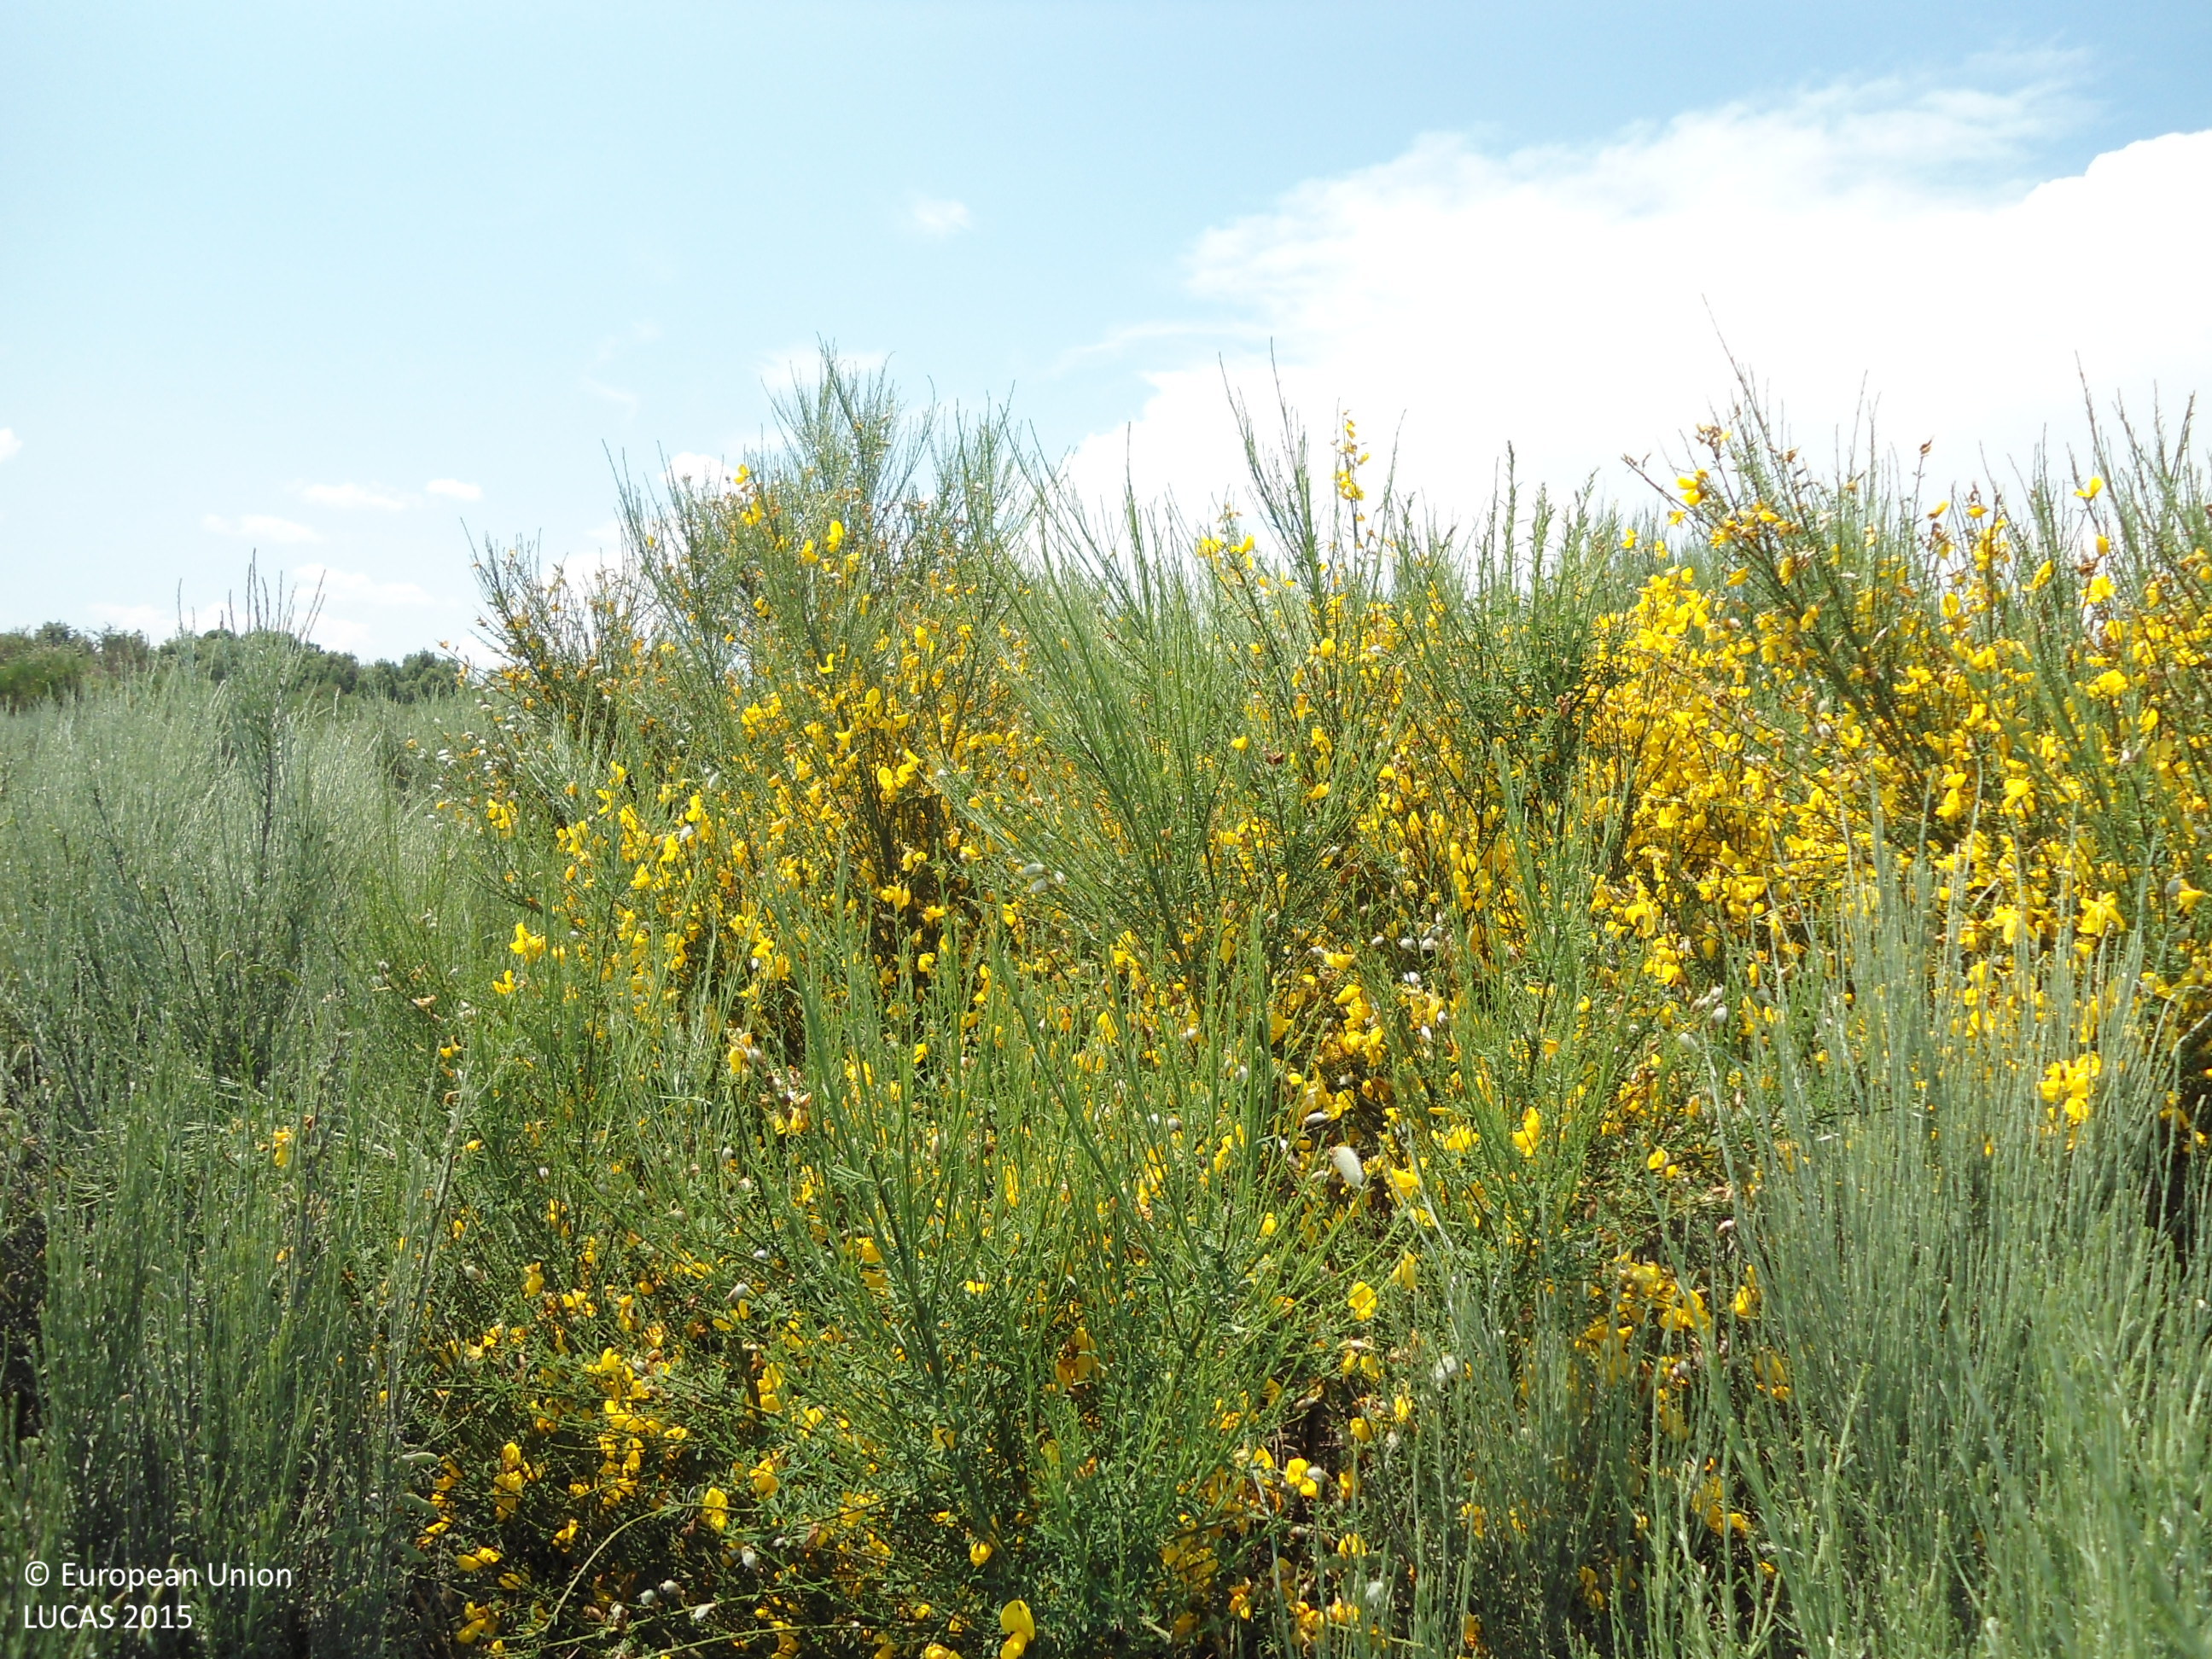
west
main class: Shrubland
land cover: Shrubland without tree cover
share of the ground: > 75 %
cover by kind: shrubs 95 %, herbaceous plants 5 %
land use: Semi-natural and natural areas not in use
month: June
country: ES
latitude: 41.9749
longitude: -6.3620
